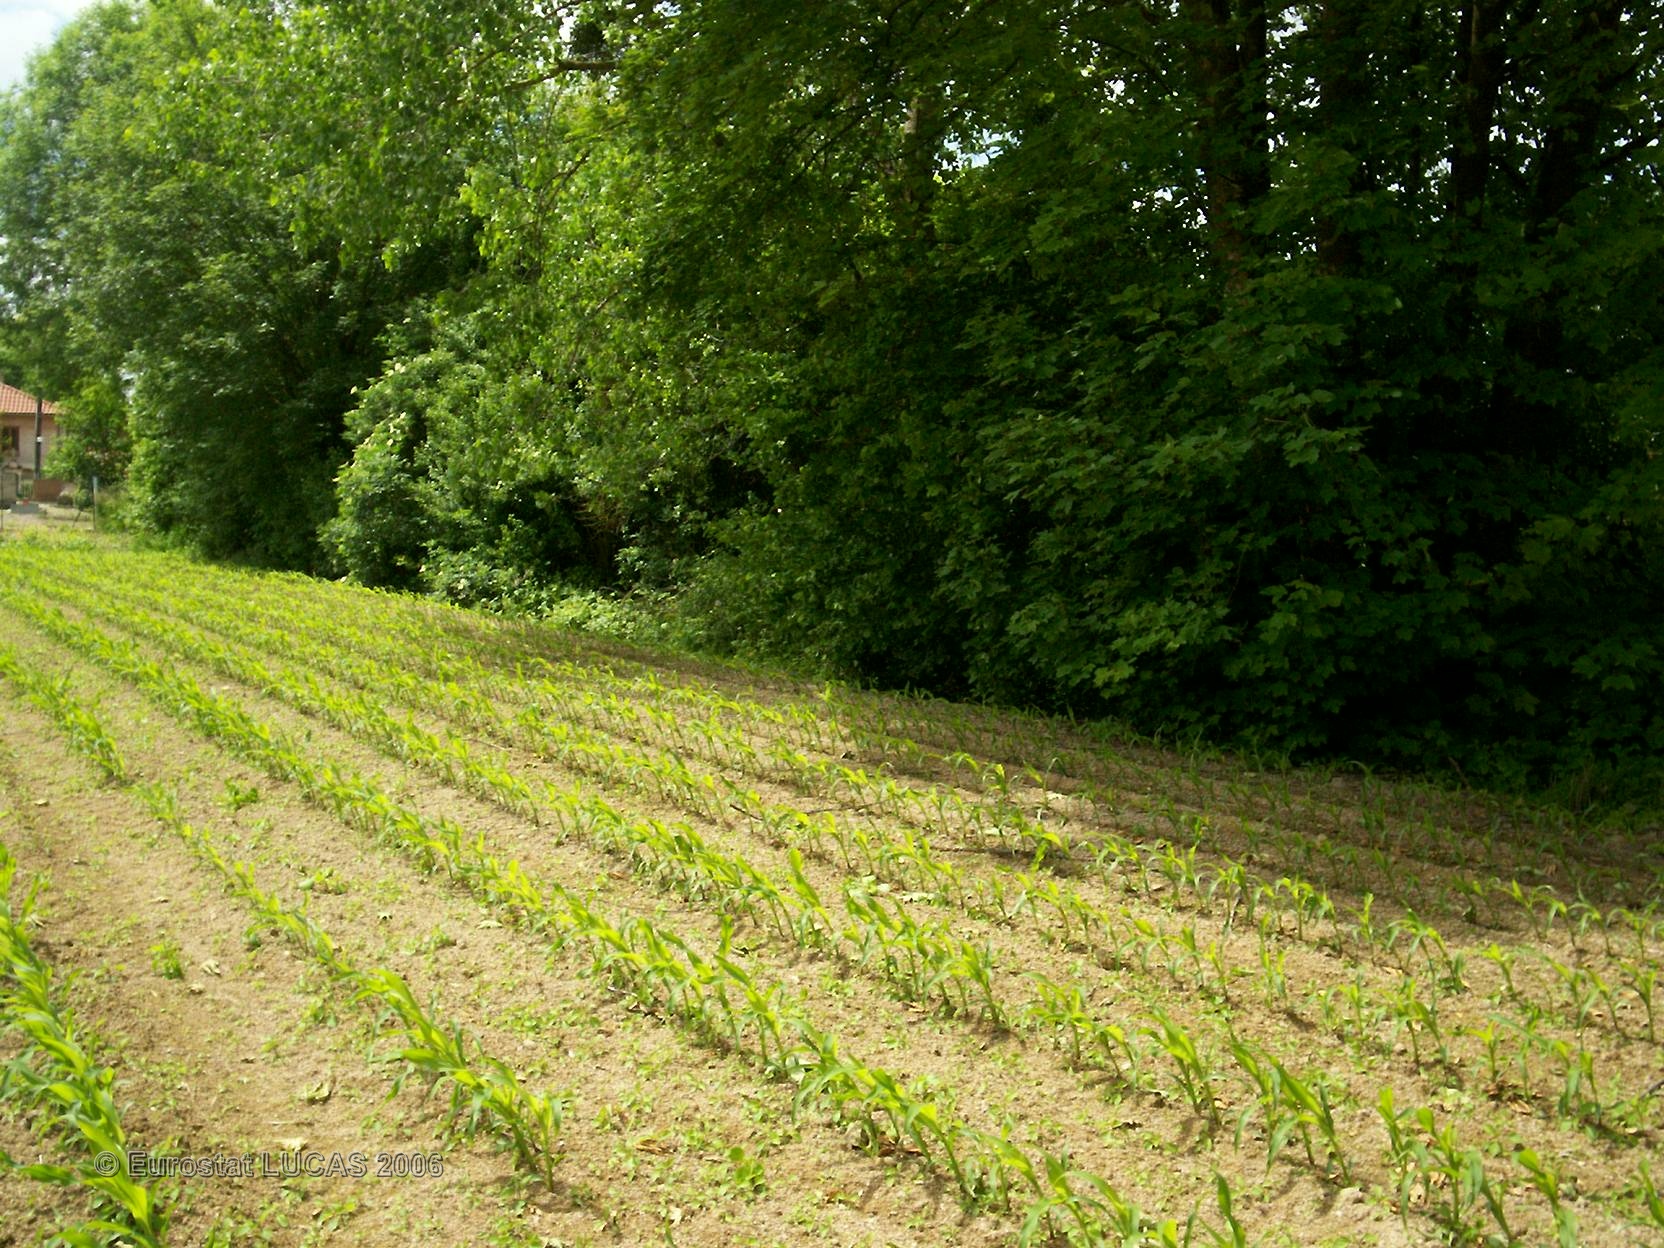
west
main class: Cropland
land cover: Maize
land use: Agriculture (excluding fallow land and kitchen gardens)
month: June
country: FR
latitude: 48.6592
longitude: 4.4169
